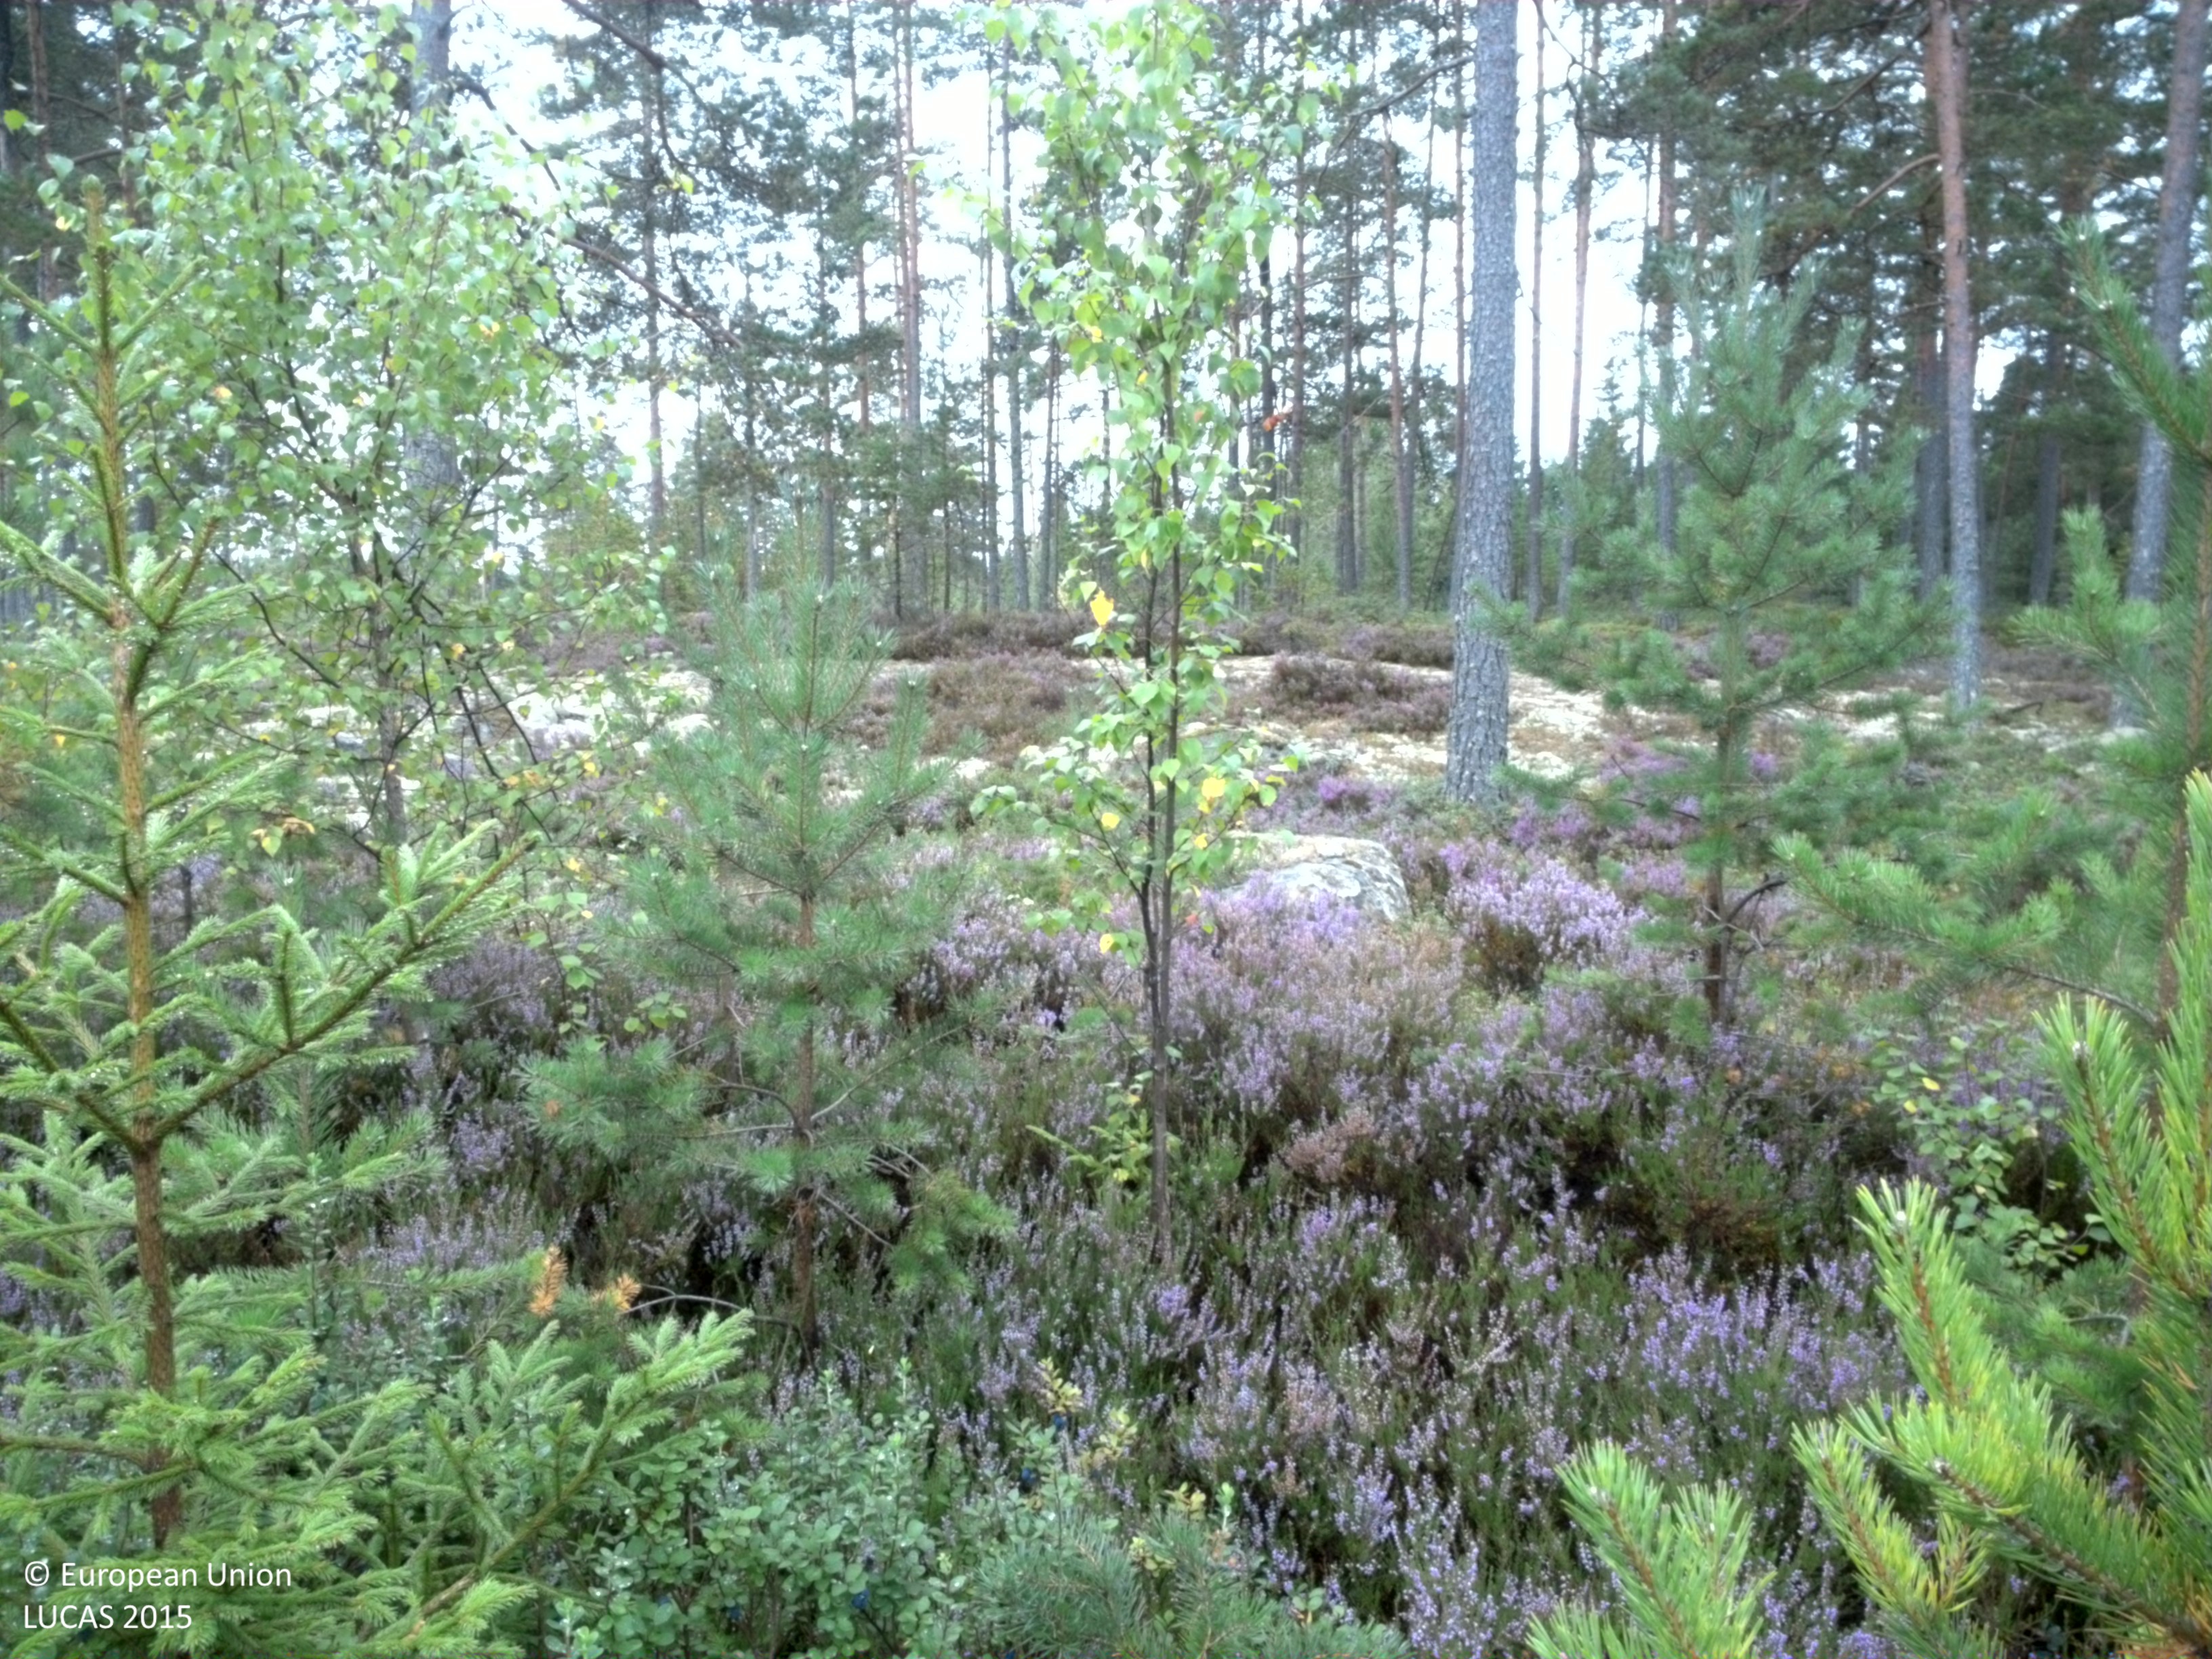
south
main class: Woodland
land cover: Pine dominated mixed woodland
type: boreal forest
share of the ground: 50 - 75 %
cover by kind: shrubs 35 %, coniferous forest trees 30 %, broadleaved forest trees 25 %, lichens and mosses 10 %
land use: Forestry
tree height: > 5 m
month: August
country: SE
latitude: 59.7972
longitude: 15.6395
